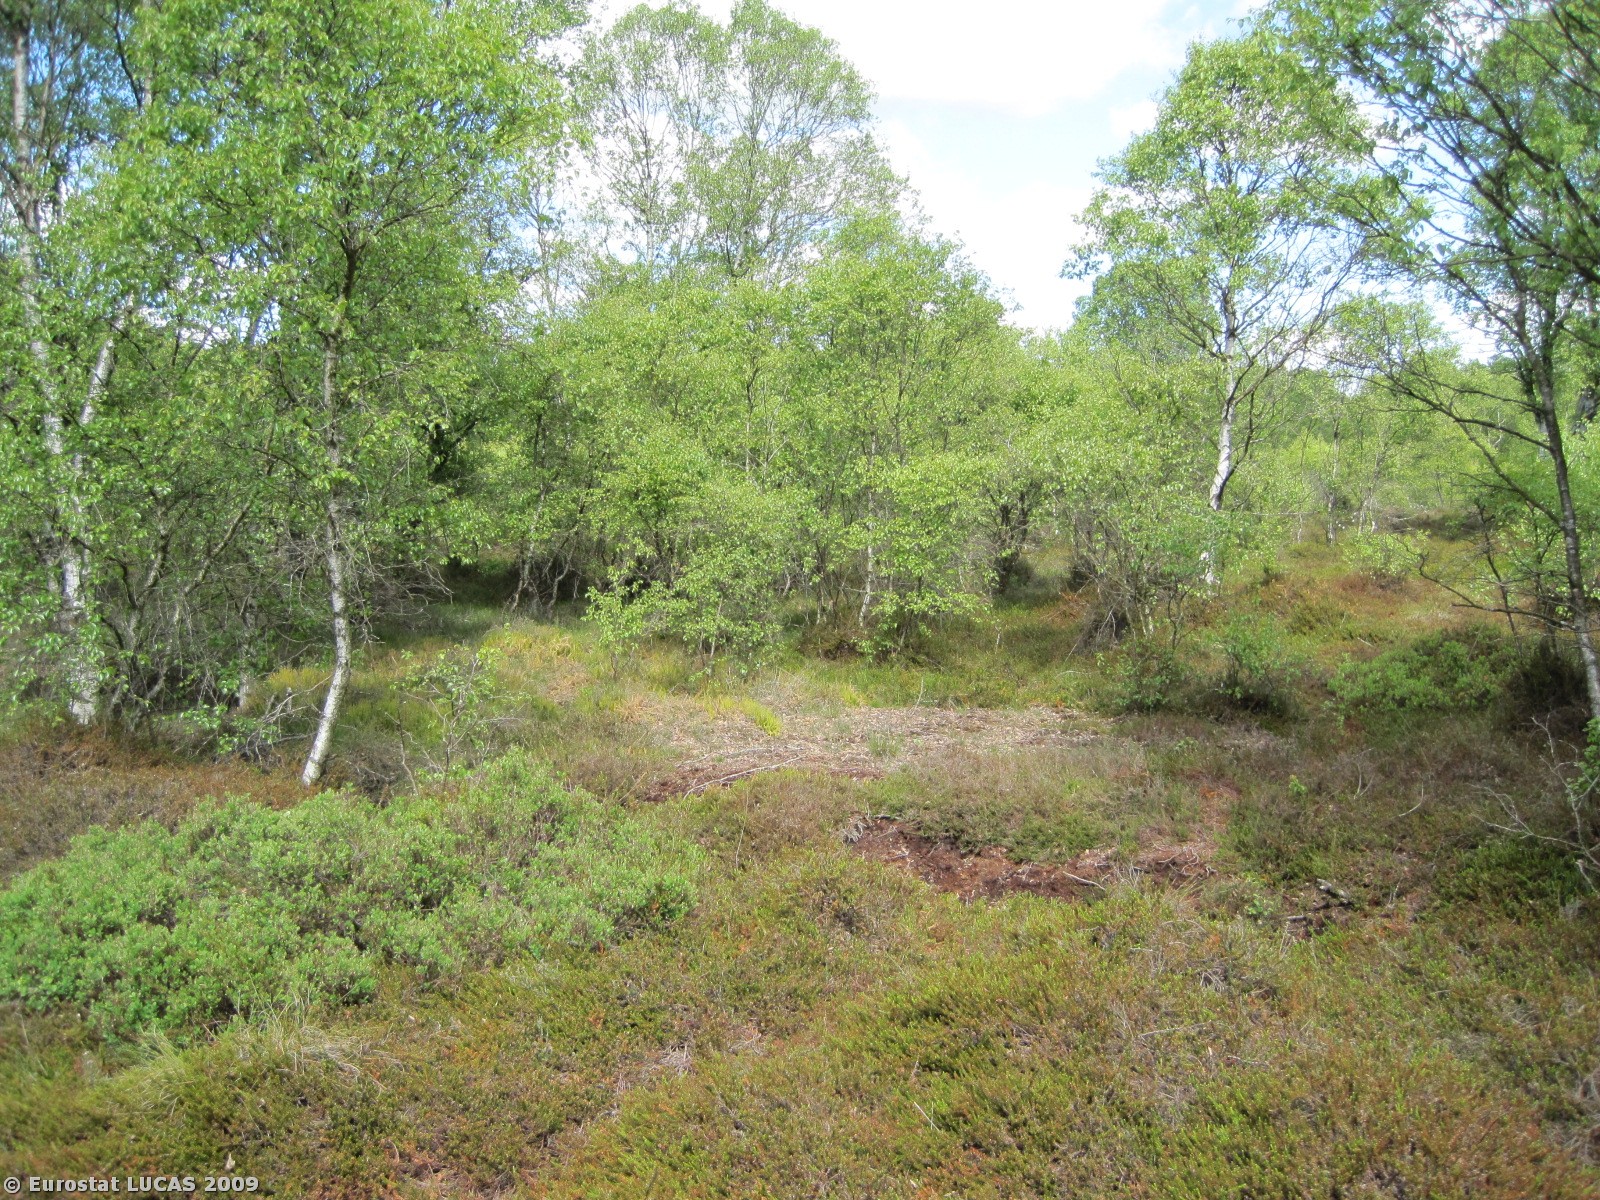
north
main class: Shrubland
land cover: Shrubland with sparse tree cover
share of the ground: > 75 %
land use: Unused
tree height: > 5 m
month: May
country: DK
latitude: 56.8887
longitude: 10.1803
